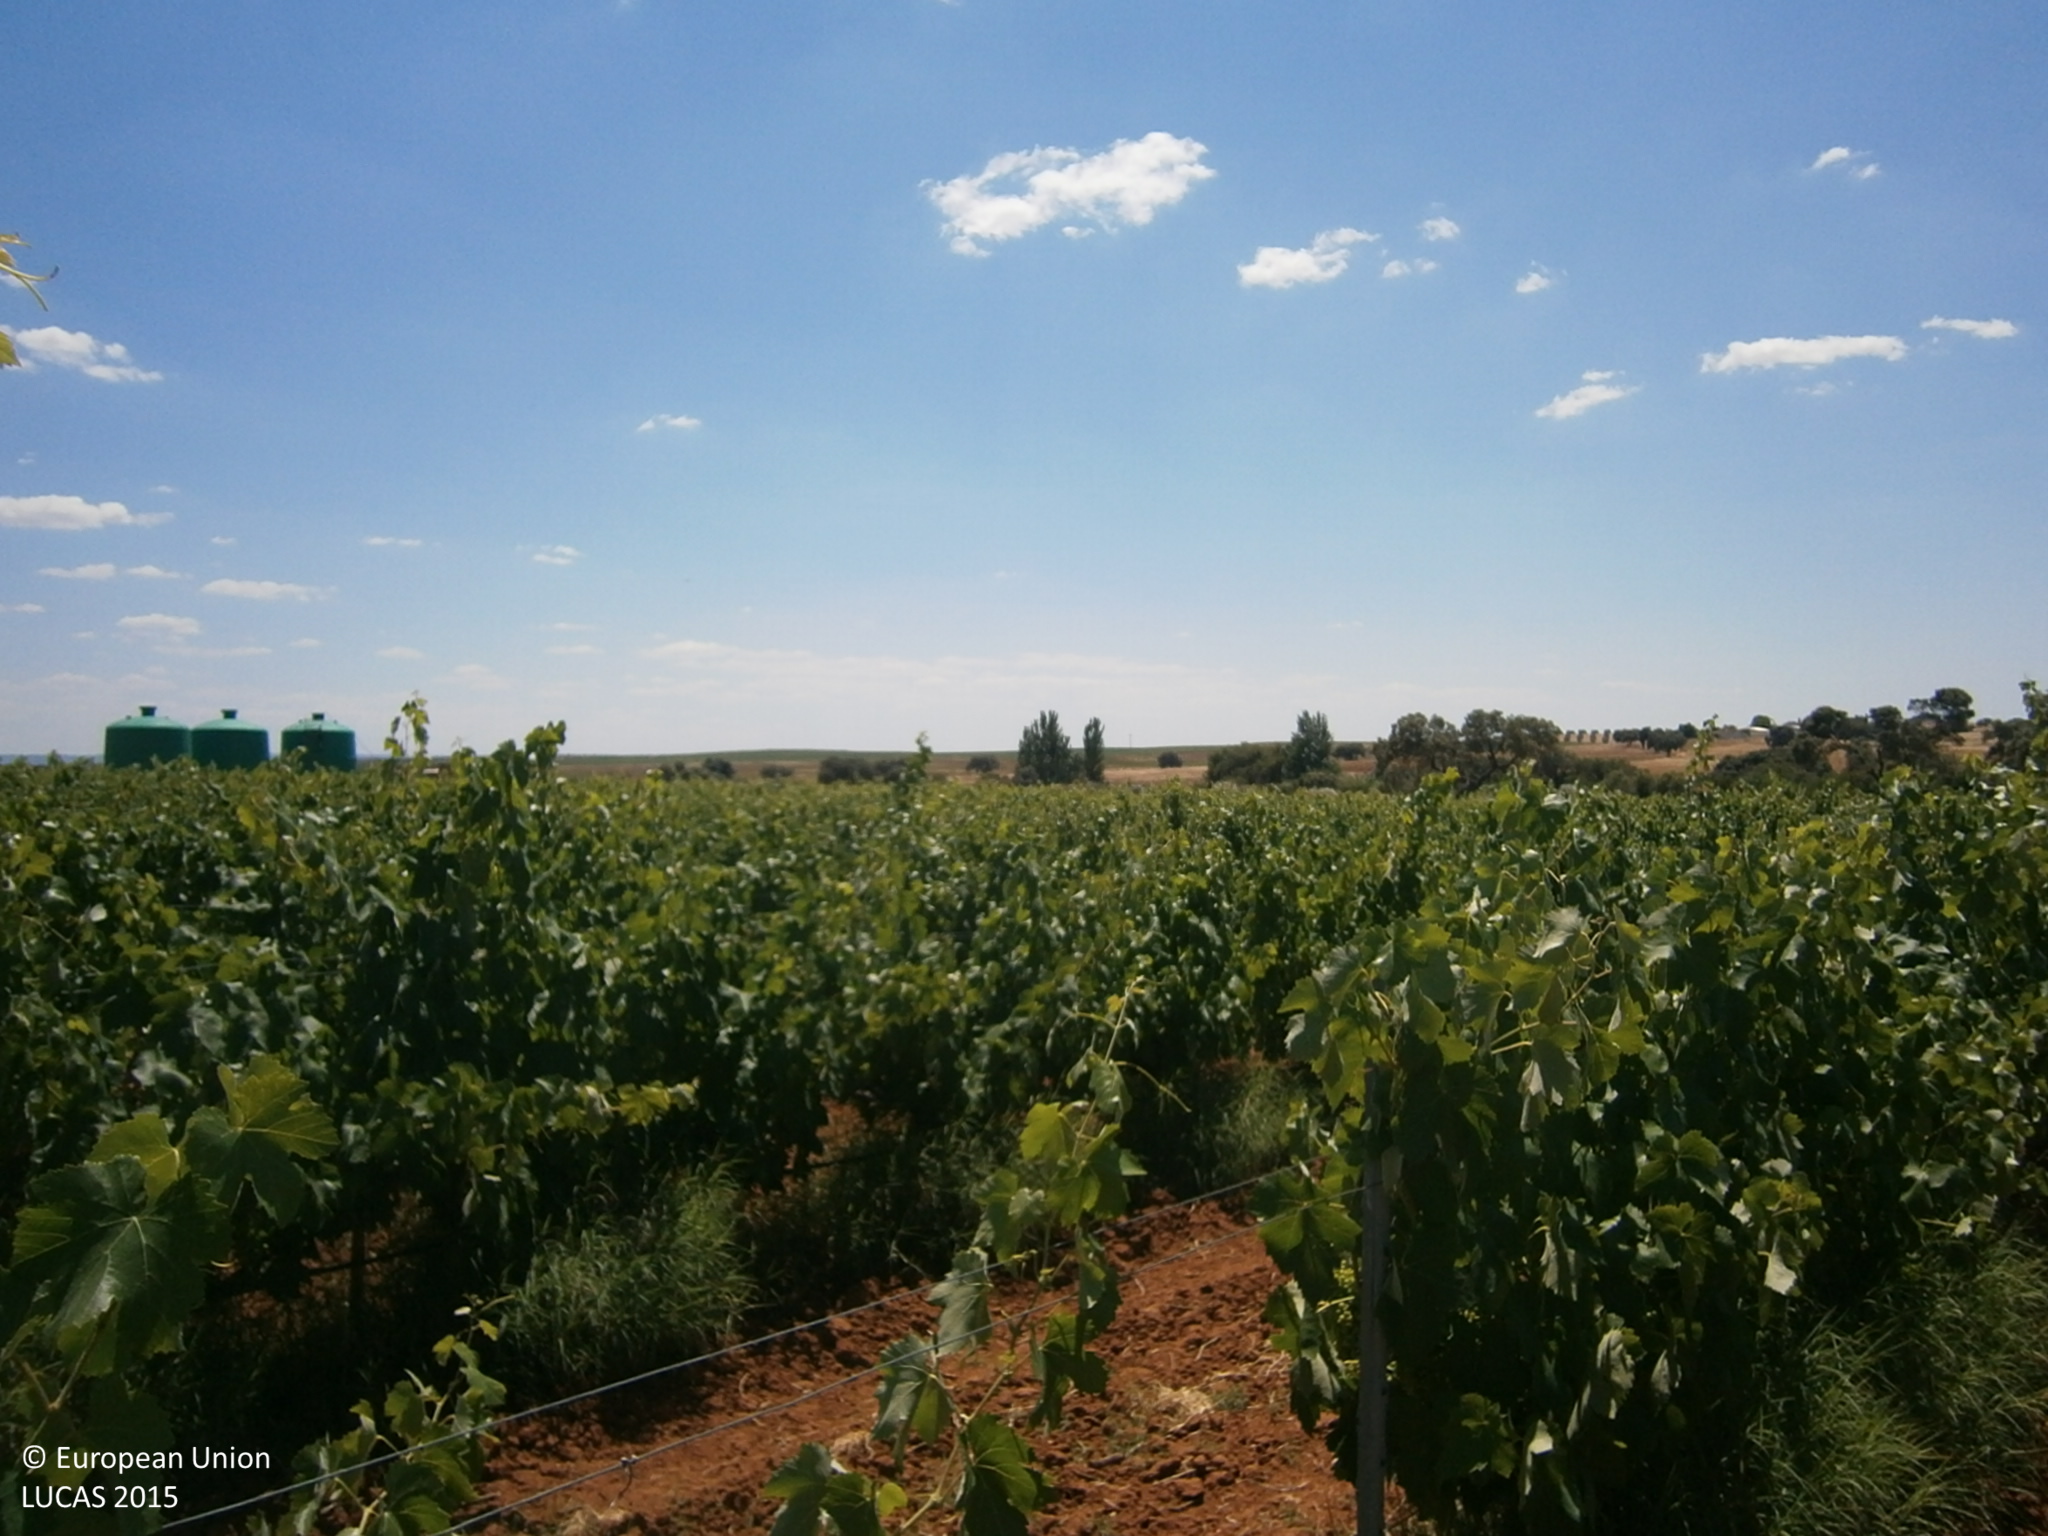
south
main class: Cropland
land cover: Vineyards
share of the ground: 50 - 75 %
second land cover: Spontaneously vegetated surfaces
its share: 10 - 25 %
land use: Agriculture (excluding fallow land and kitchen gardens)
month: June
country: ES
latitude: 38.7783
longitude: -6.6484
